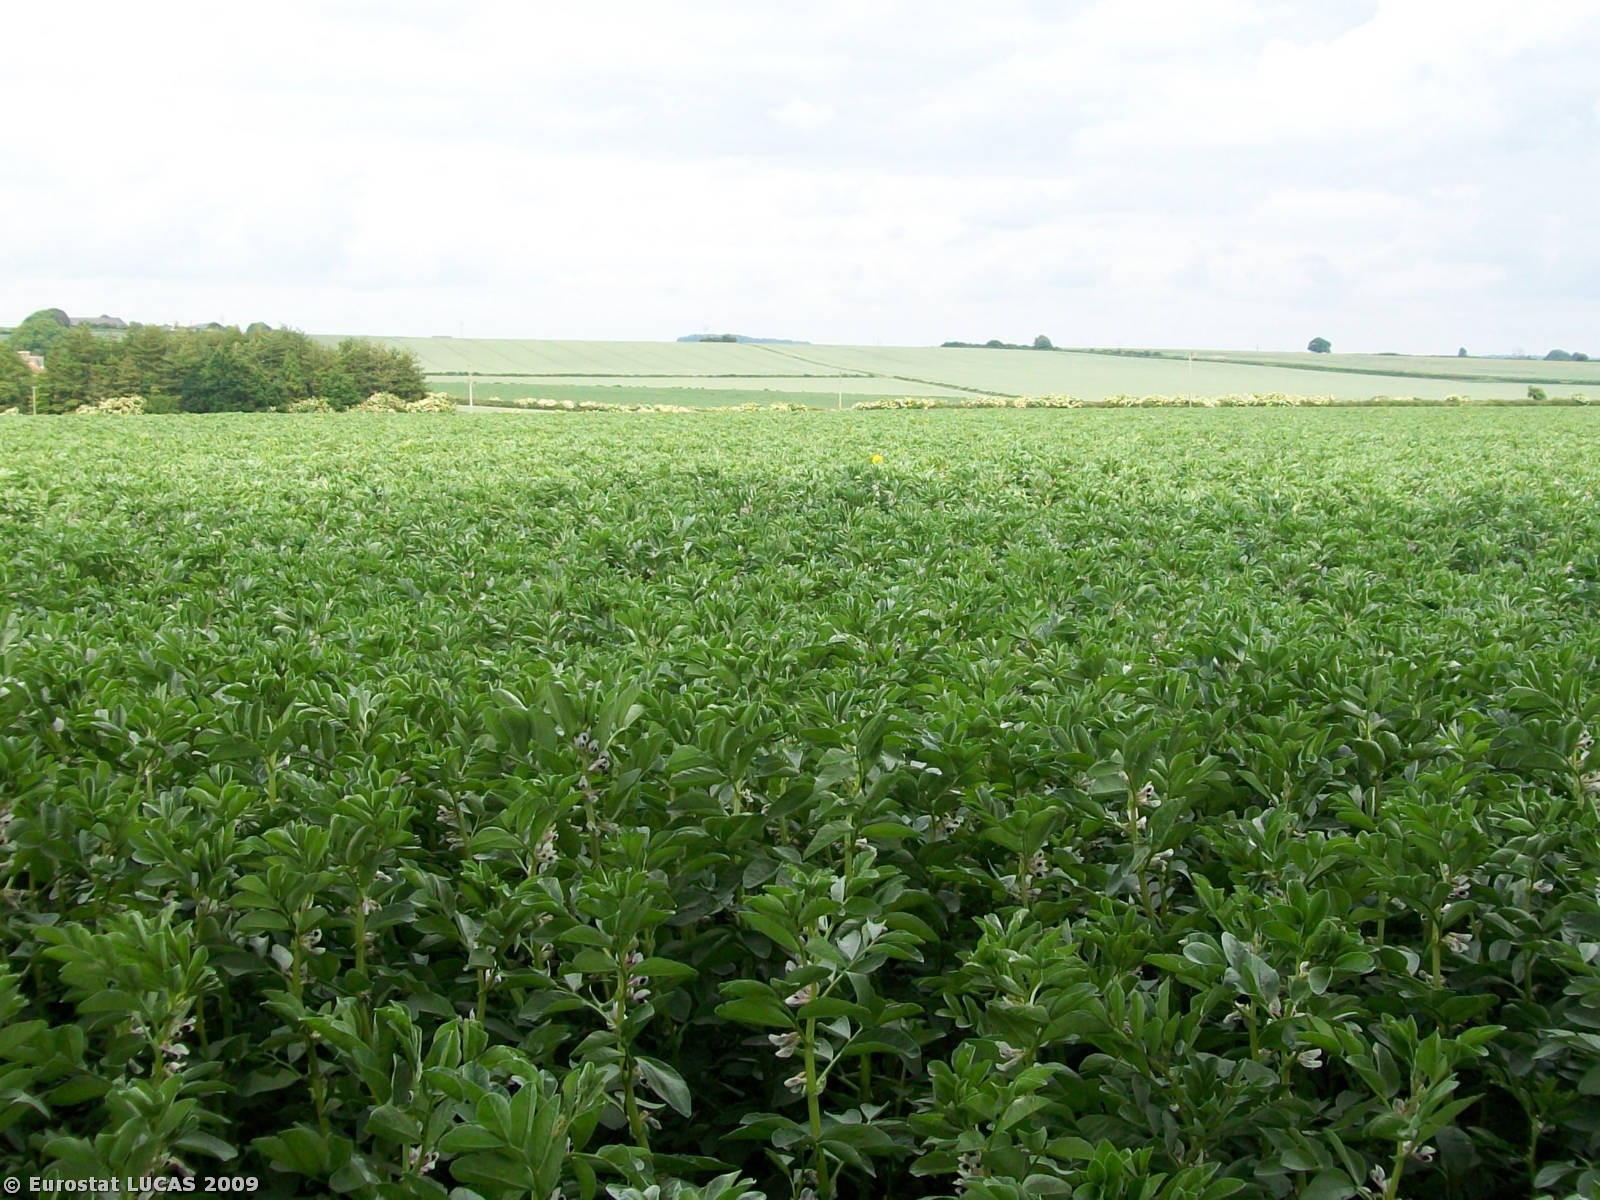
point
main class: Cropland
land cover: Dry pulses
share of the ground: > 75 %
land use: Agriculture (excluding fallow land and kitchen gardens)
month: June
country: GB
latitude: 50.8062
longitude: -2.1364
